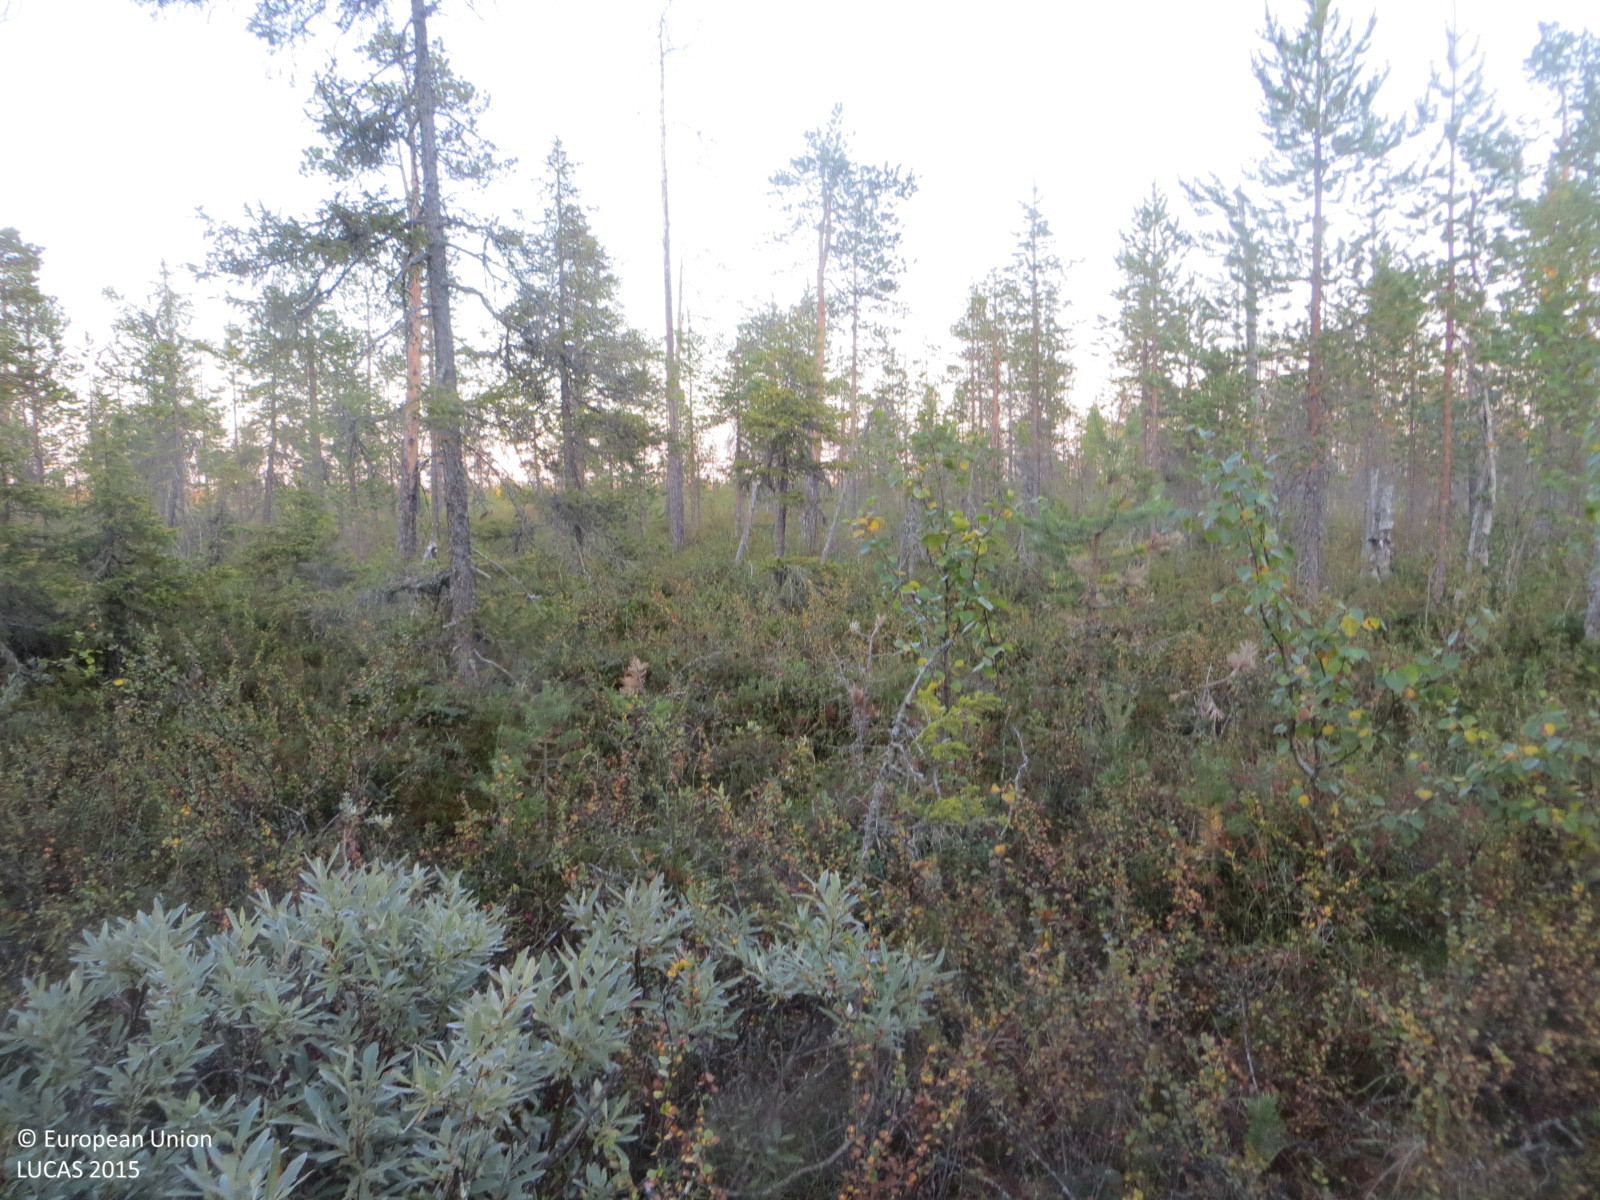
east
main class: Woodland
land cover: Pine dominated mixed woodland
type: mire and swamp forests
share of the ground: 50 - 75 %
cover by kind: shrubs 50 %, coniferous forest trees 30 %, broadleaved forest trees 20 %
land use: Forestry
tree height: > 5 m
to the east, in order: Pine dominated mixed woodland; Pine dominated coniferous woodland; Peatbogs
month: August
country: FI
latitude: 67.7420
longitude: 24.8667
